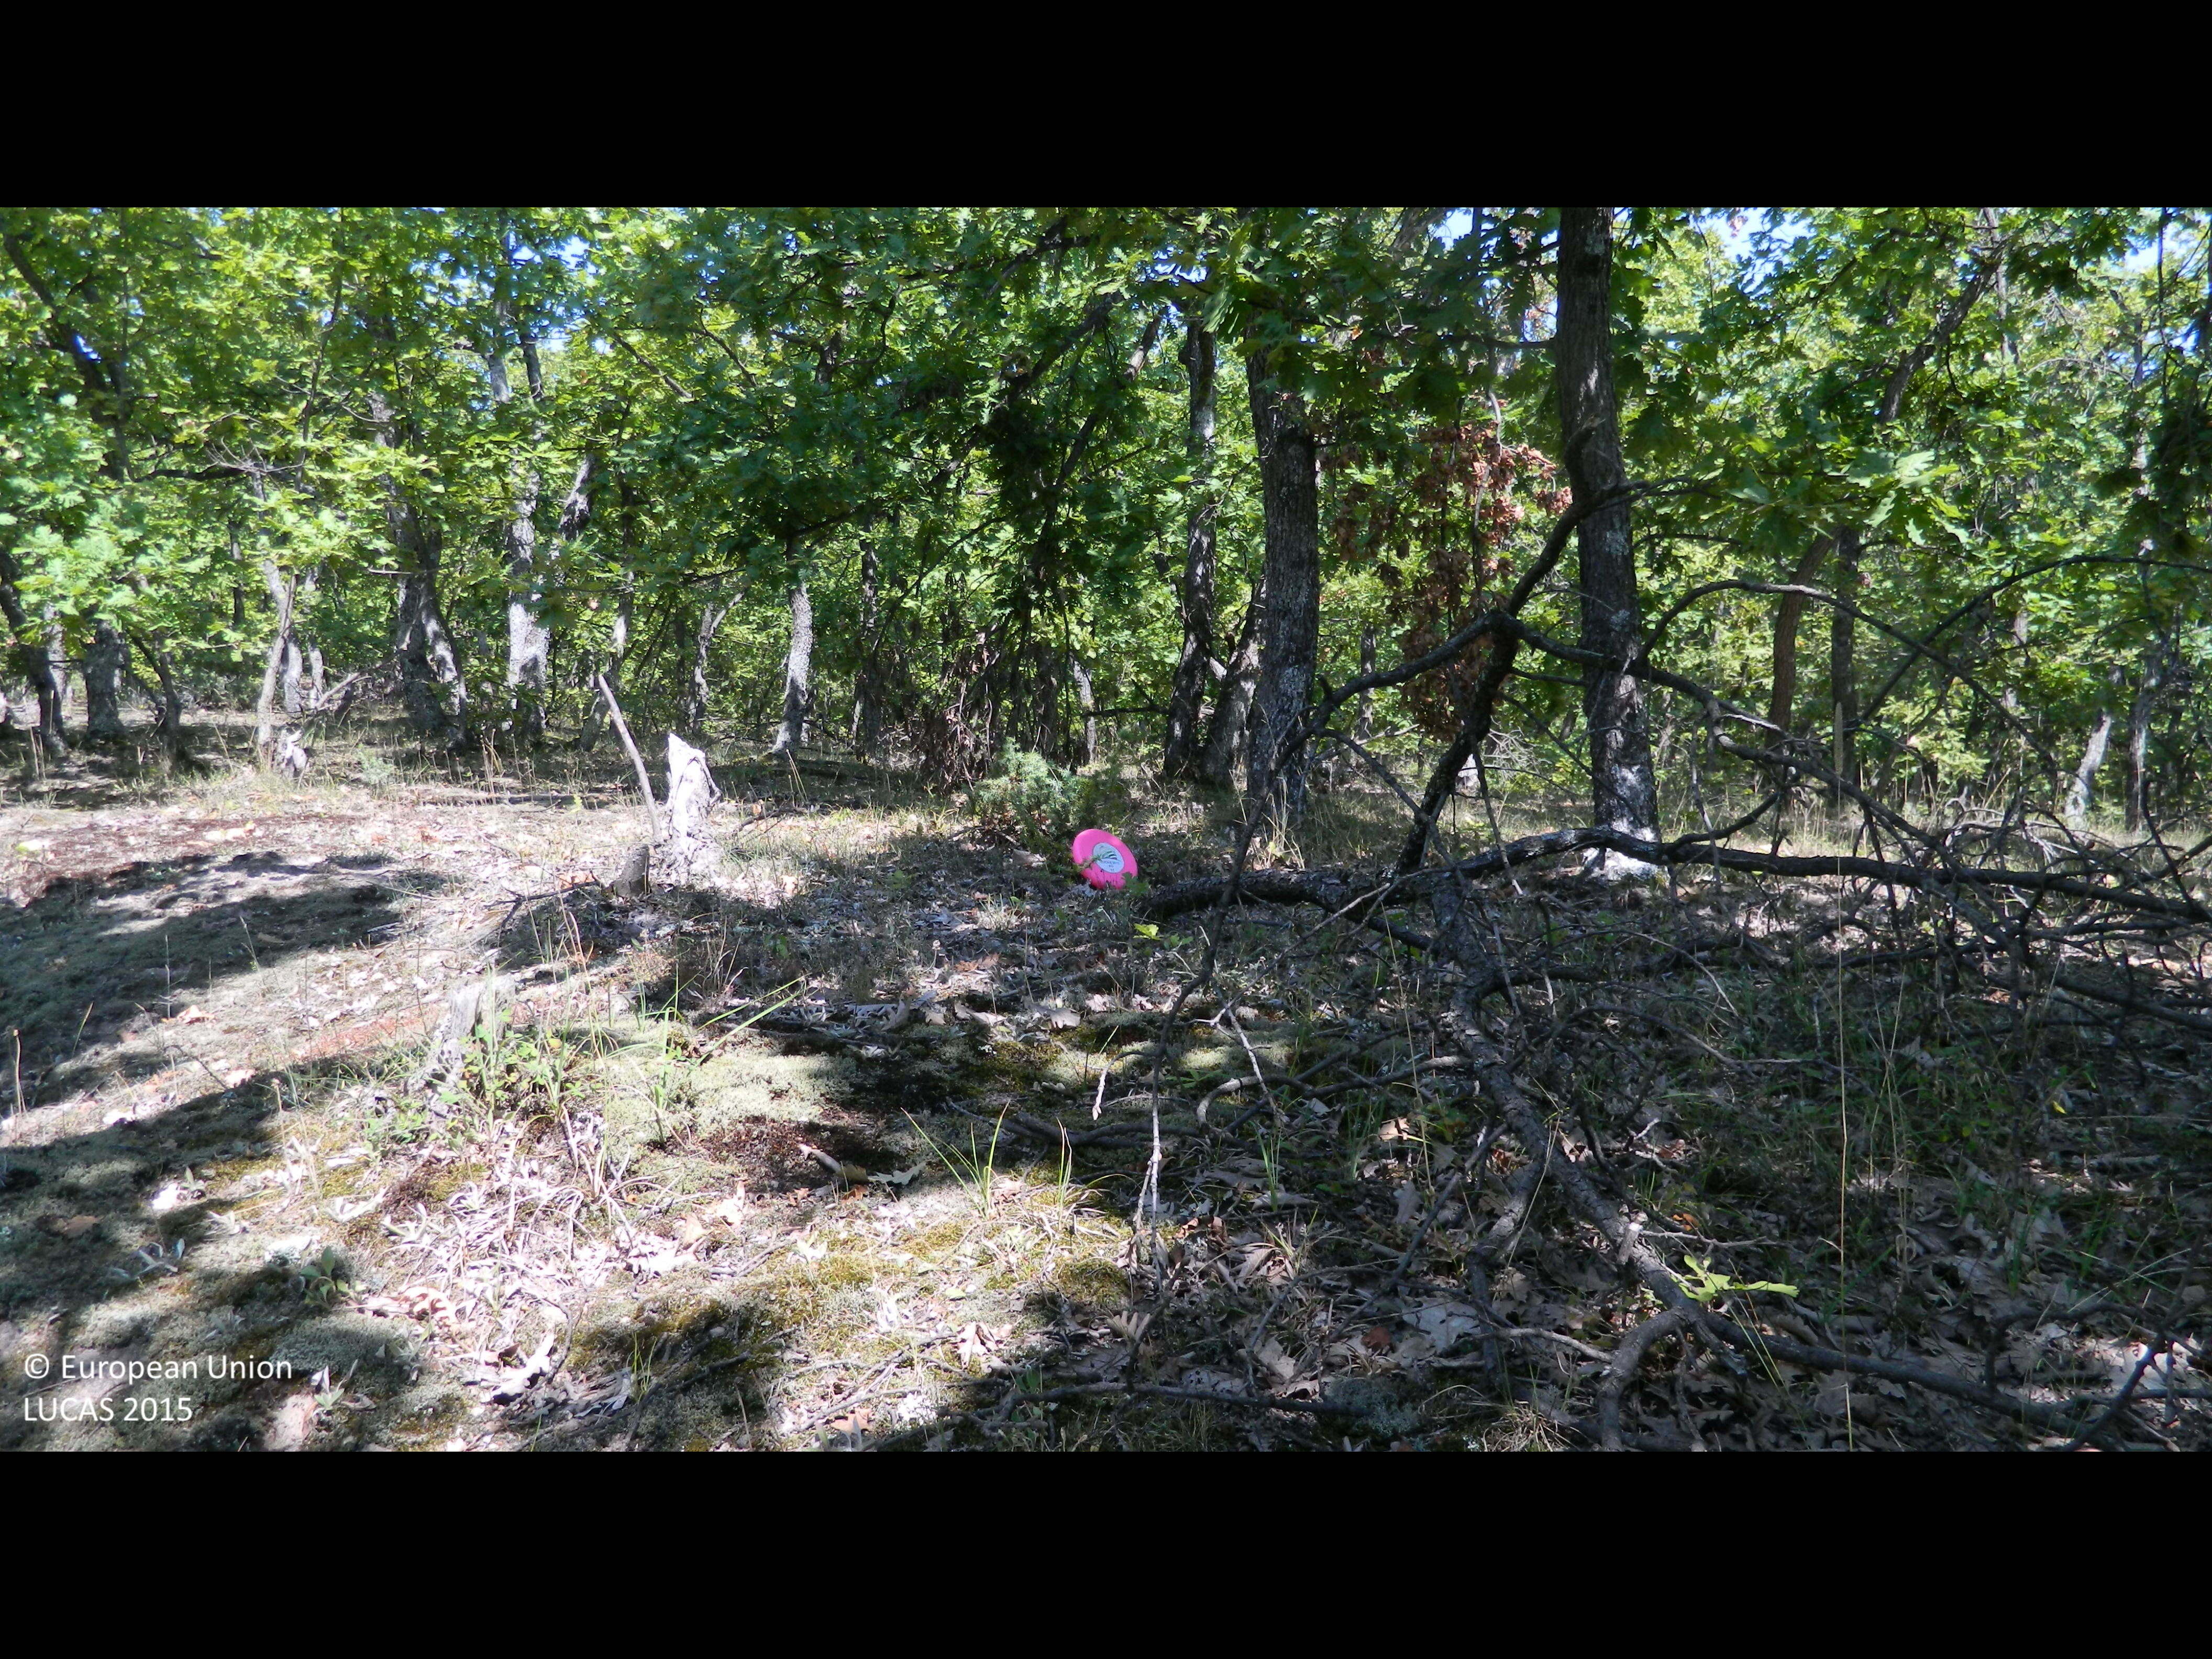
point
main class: Woodland
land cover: Broadleaved woodland
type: thermophilous deciduous forest
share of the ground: > 75 %
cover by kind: broadleaved forest trees 85 %, herbaceous plants 10 %, unconsolidated bare surface 5 %
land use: Forestry
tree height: > 5 m
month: September
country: BG
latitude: 41.6829
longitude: 25.6686
